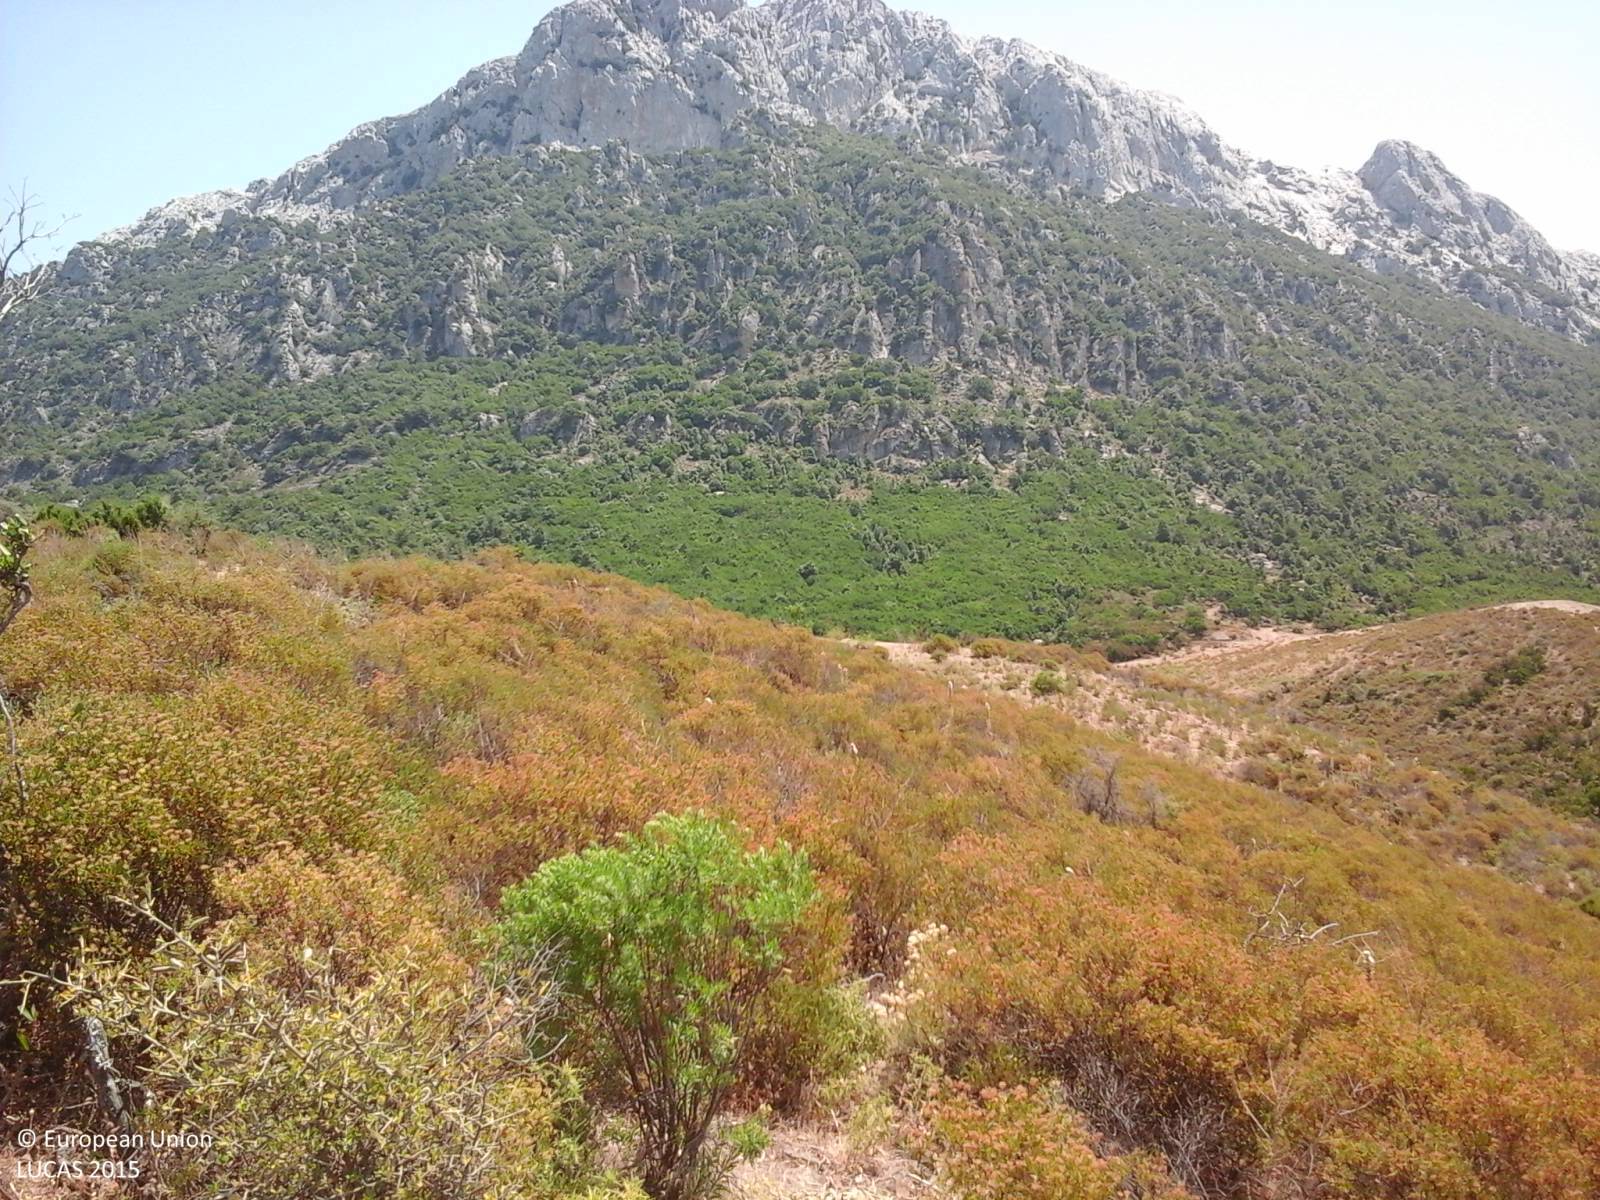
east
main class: Shrubland
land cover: Shrubland without tree cover
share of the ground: > 75 %
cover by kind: shrubs 95 %, herbaceous plants 5 %
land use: Semi-natural and natural areas not in use
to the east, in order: Shrubland without tree cover; Grassland without tree/shrub cover; Shrubland without tree cover
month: July
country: IT
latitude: 40.4834
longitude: 9.5188
